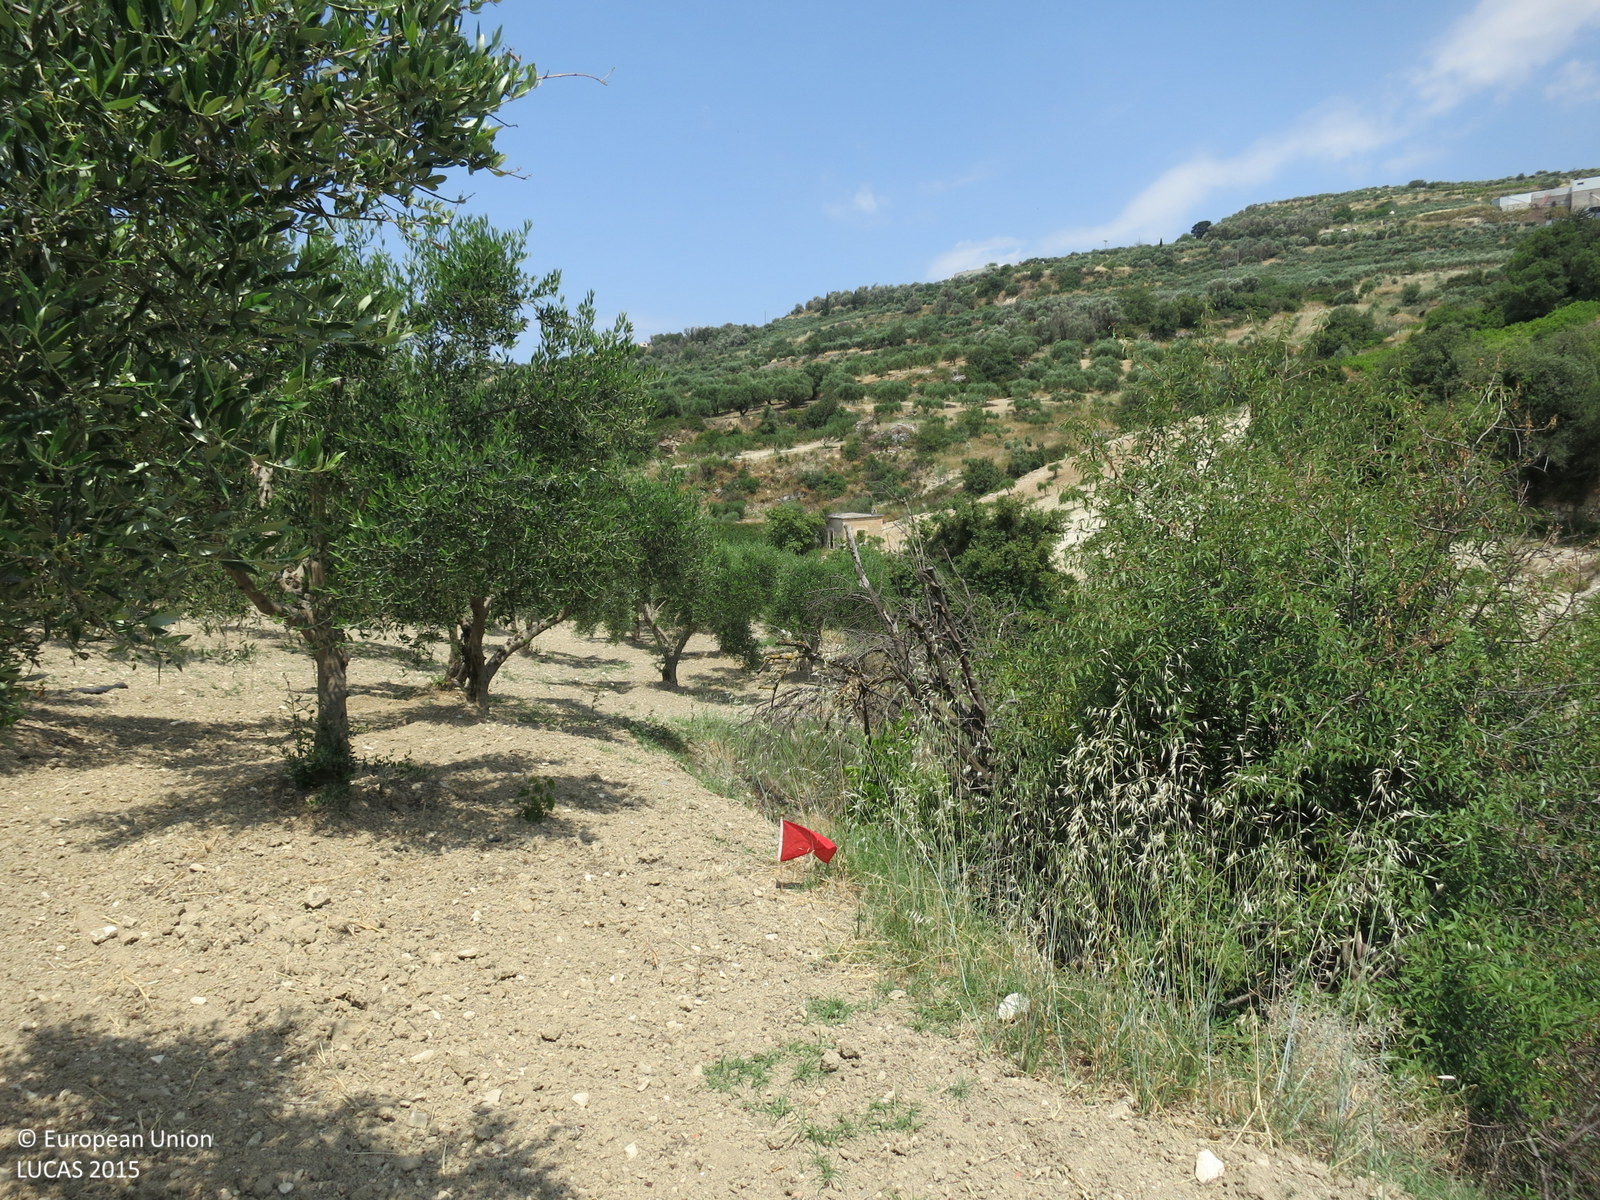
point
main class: Cropland
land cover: Olive groves
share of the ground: 25 - 50 %
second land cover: Other bare soil
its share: > 75 %
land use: Agriculture (excluding fallow land and kitchen gardens)
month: June
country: GR
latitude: 35.2225
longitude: 25.0083
